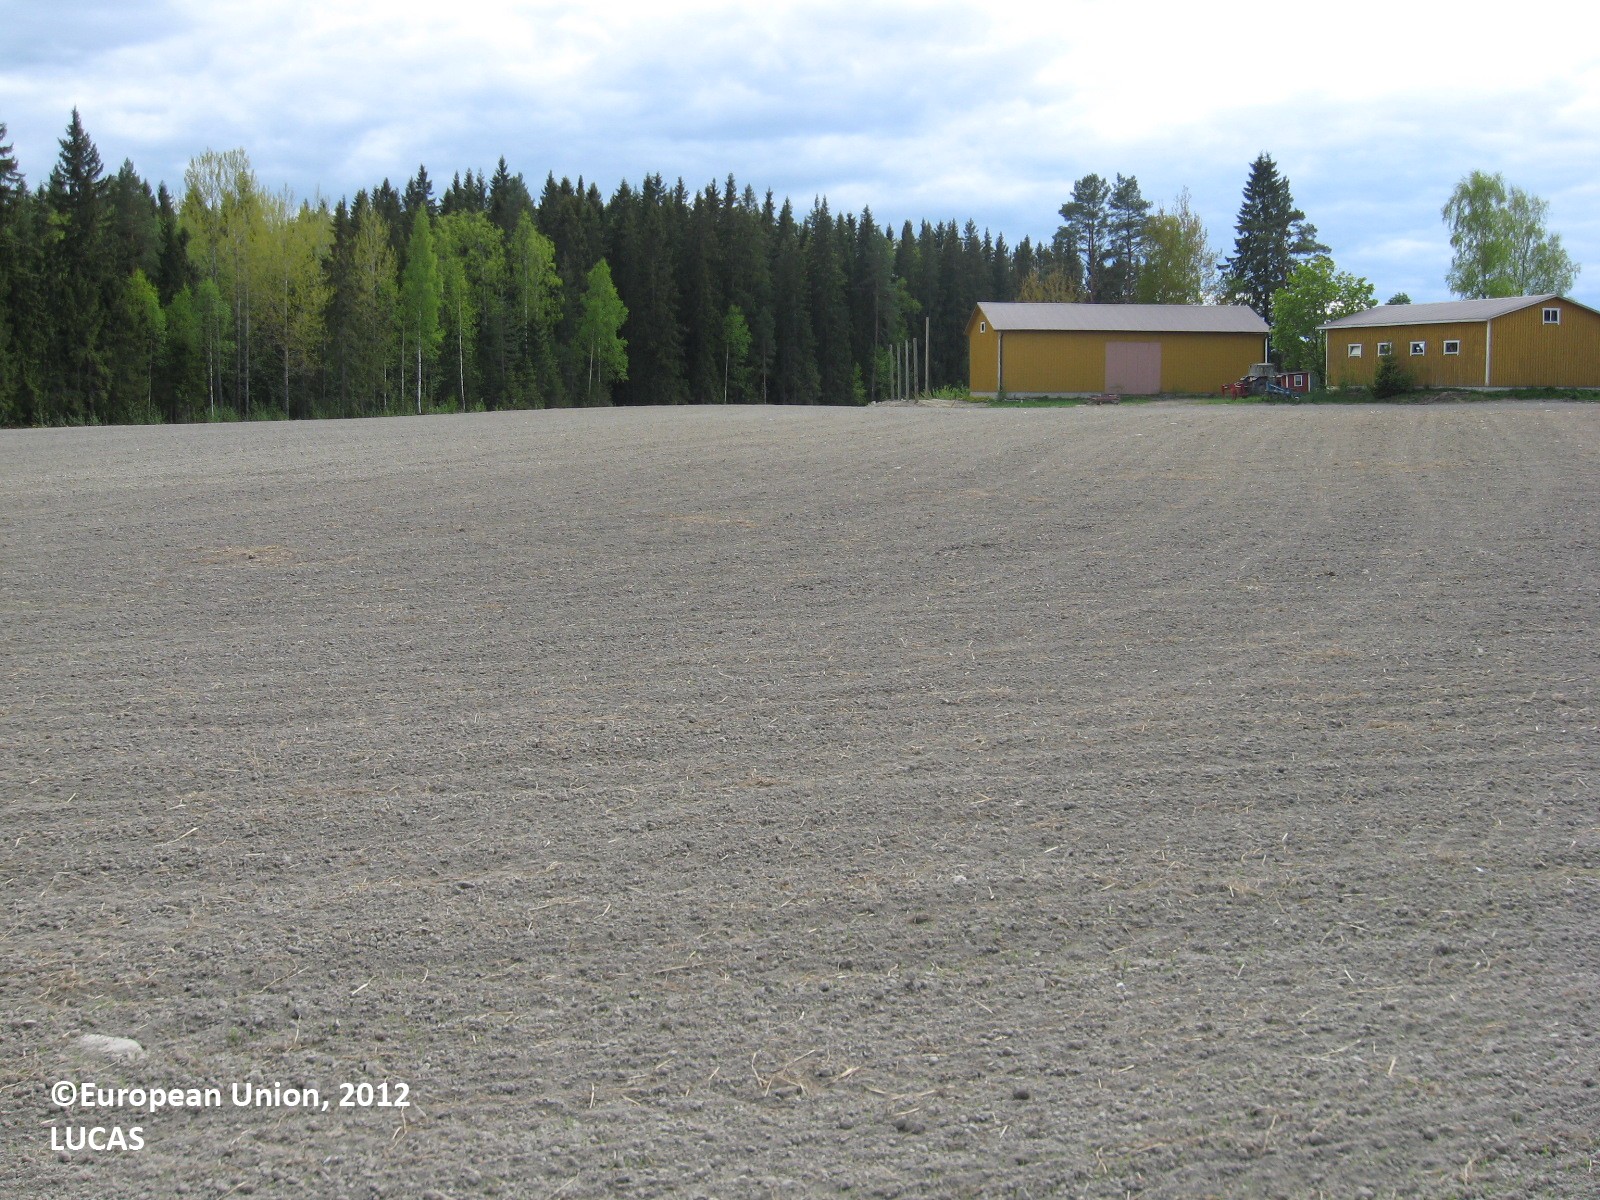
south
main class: Cropland
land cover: Barley
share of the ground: < 10 %
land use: Agriculture (excluding fallow land and kitchen gardens)
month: May
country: FI
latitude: 61.8347
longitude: 22.6928
